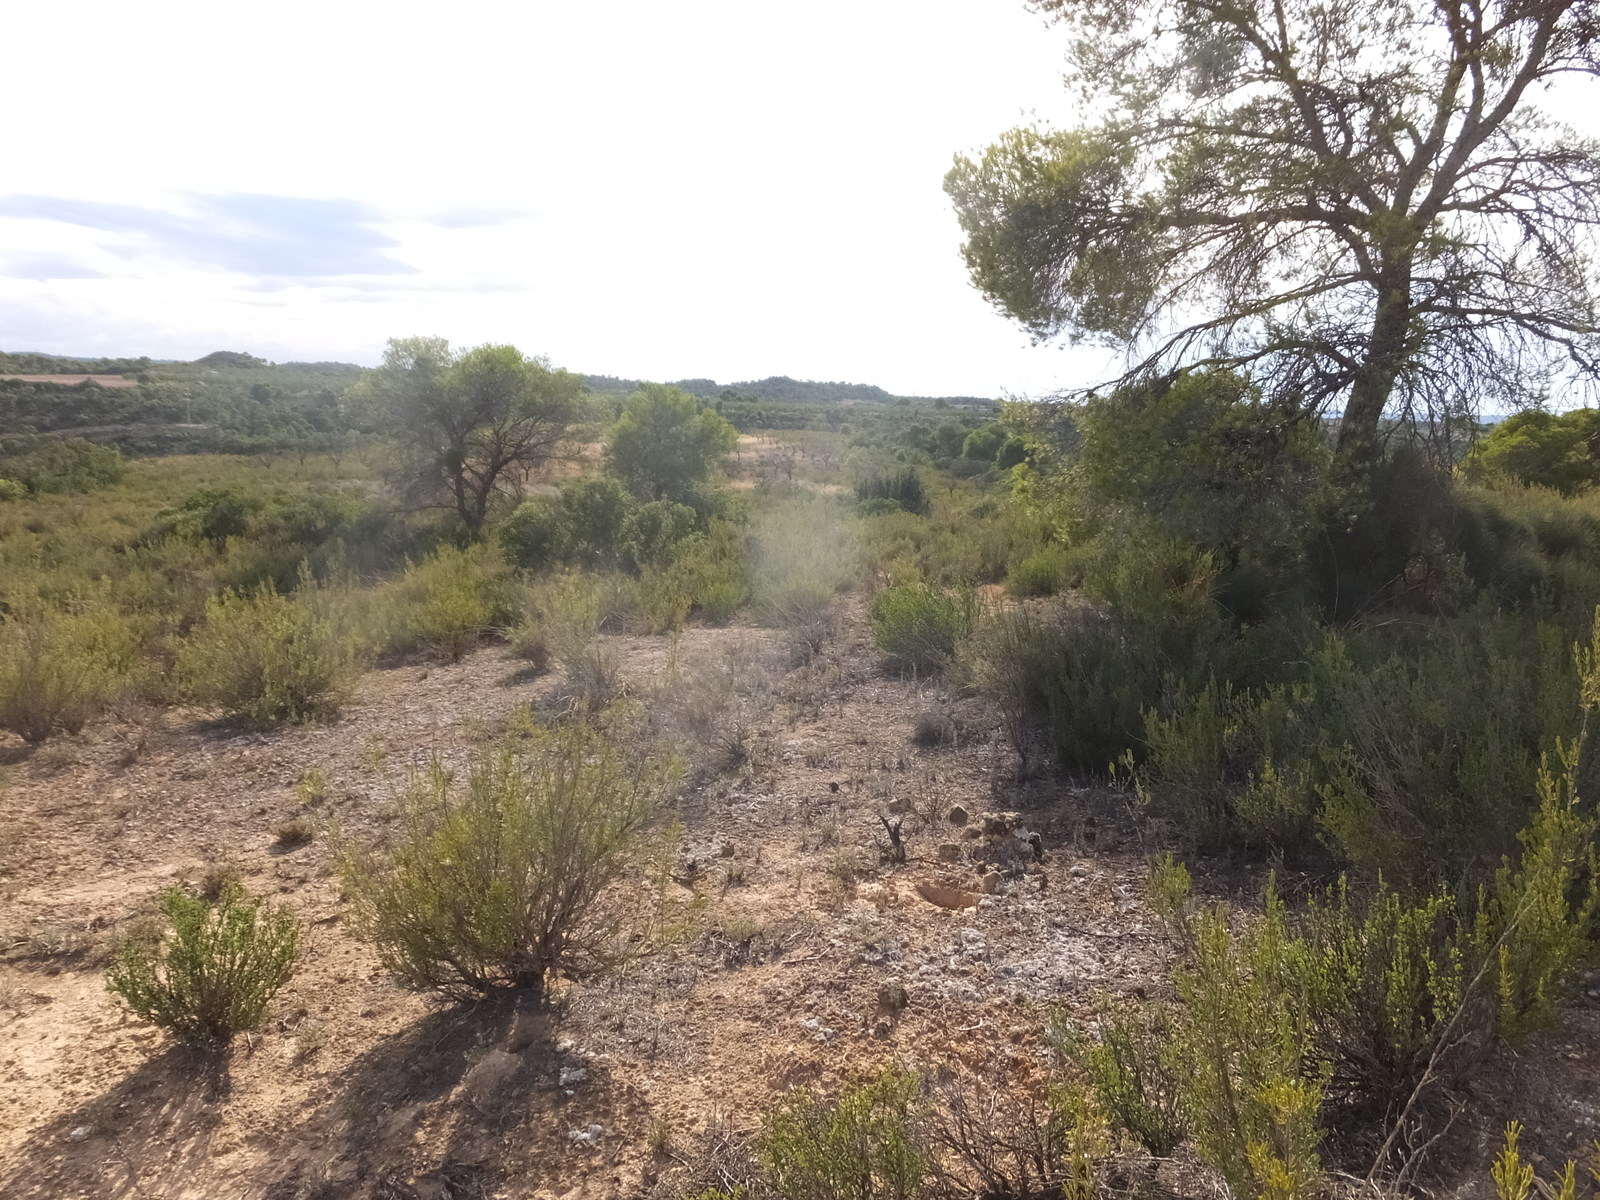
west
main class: Shrubland
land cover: Shrubland with sparse tree cover
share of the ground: > 75 %
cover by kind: shrubs 75 %, herbaceous plants 15 %, coniferous forest trees 5 %, unconsolidated bare surface 5 %
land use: Semi-natural and natural areas not in use
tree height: < 5 m
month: August
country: ES
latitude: 41.2781
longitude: 0.1146
